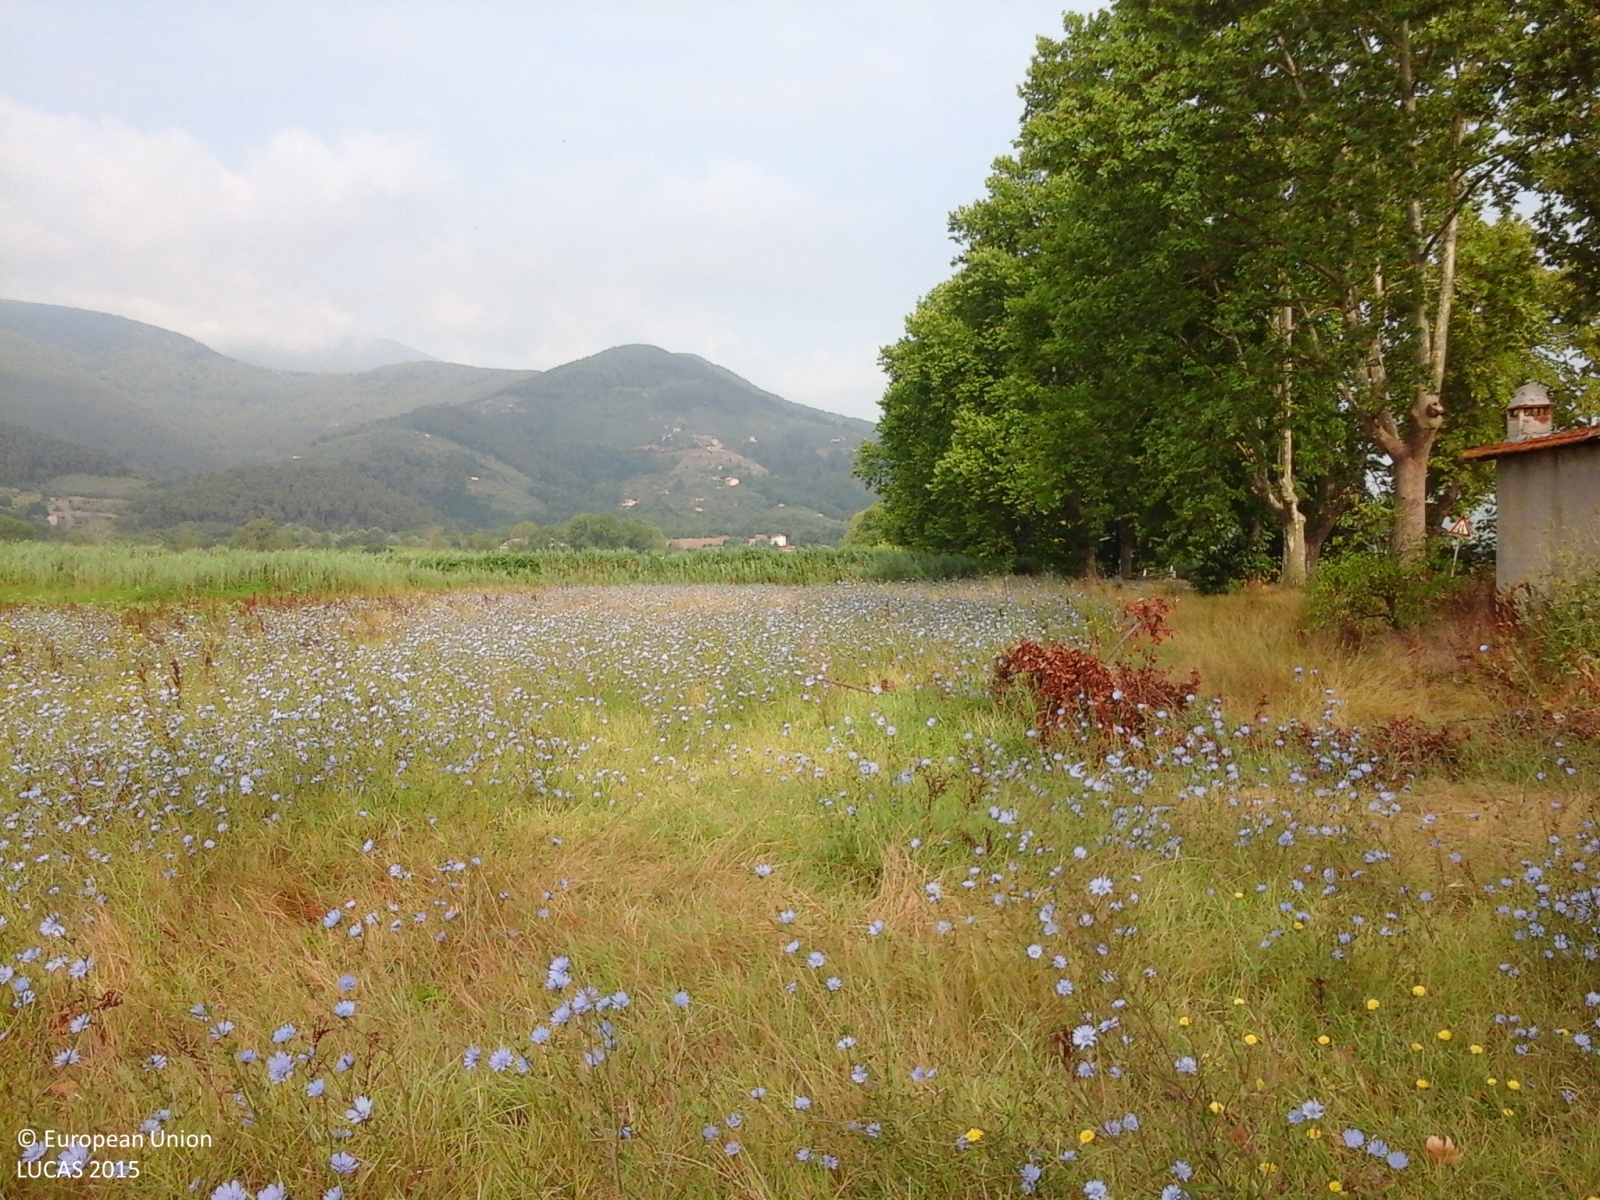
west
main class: Grassland
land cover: Grassland without tree/shrub cover
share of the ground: > 75 %
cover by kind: herbaceous plants 95 %, shrubs 5 %
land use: Agriculture (excluding fallow land and kitchen gardens)
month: July
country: IT
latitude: 43.7533
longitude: 10.6317
